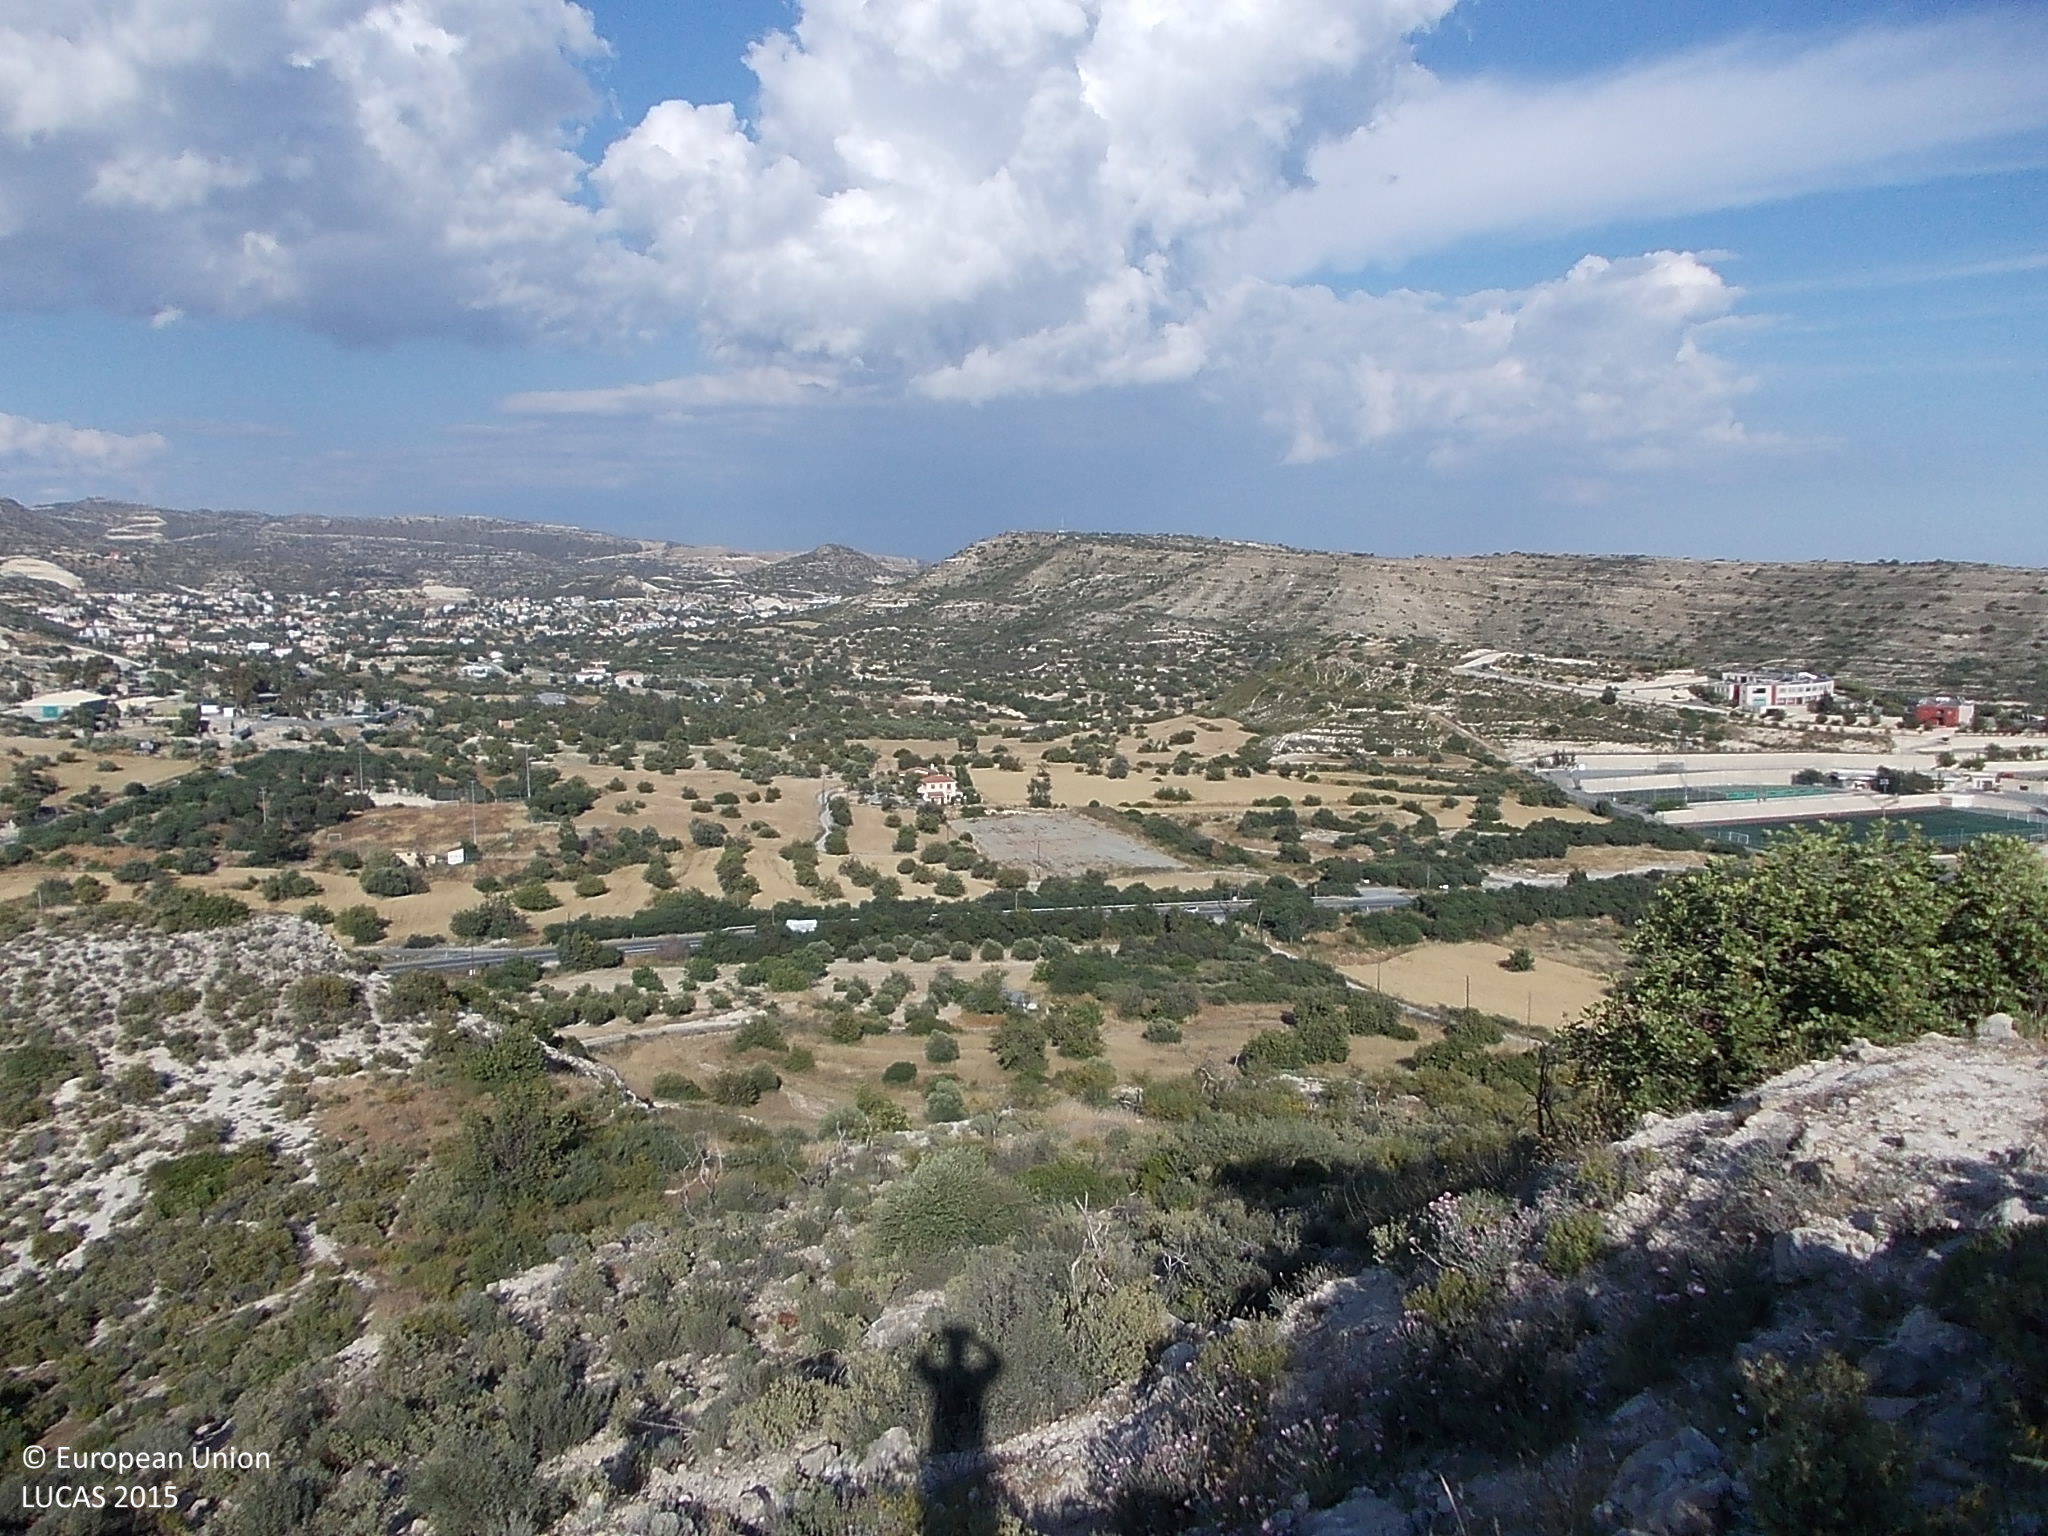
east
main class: Shrubland
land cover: Shrubland without tree cover
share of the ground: 50 - 75 %
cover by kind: shrubs 60 %, unconsolidated bare surface 20 %, herbaceous plants 15 %, consolidated bare surface 5 %
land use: Semi-natural and natural areas not in use
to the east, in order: Shrubland without tree cover; Grassland with sparse tree/shrub cover; Shrubland without tree cover; Fences; Tracks; Nuts trees
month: May
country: CY
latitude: 34.7424
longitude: 32.9819
